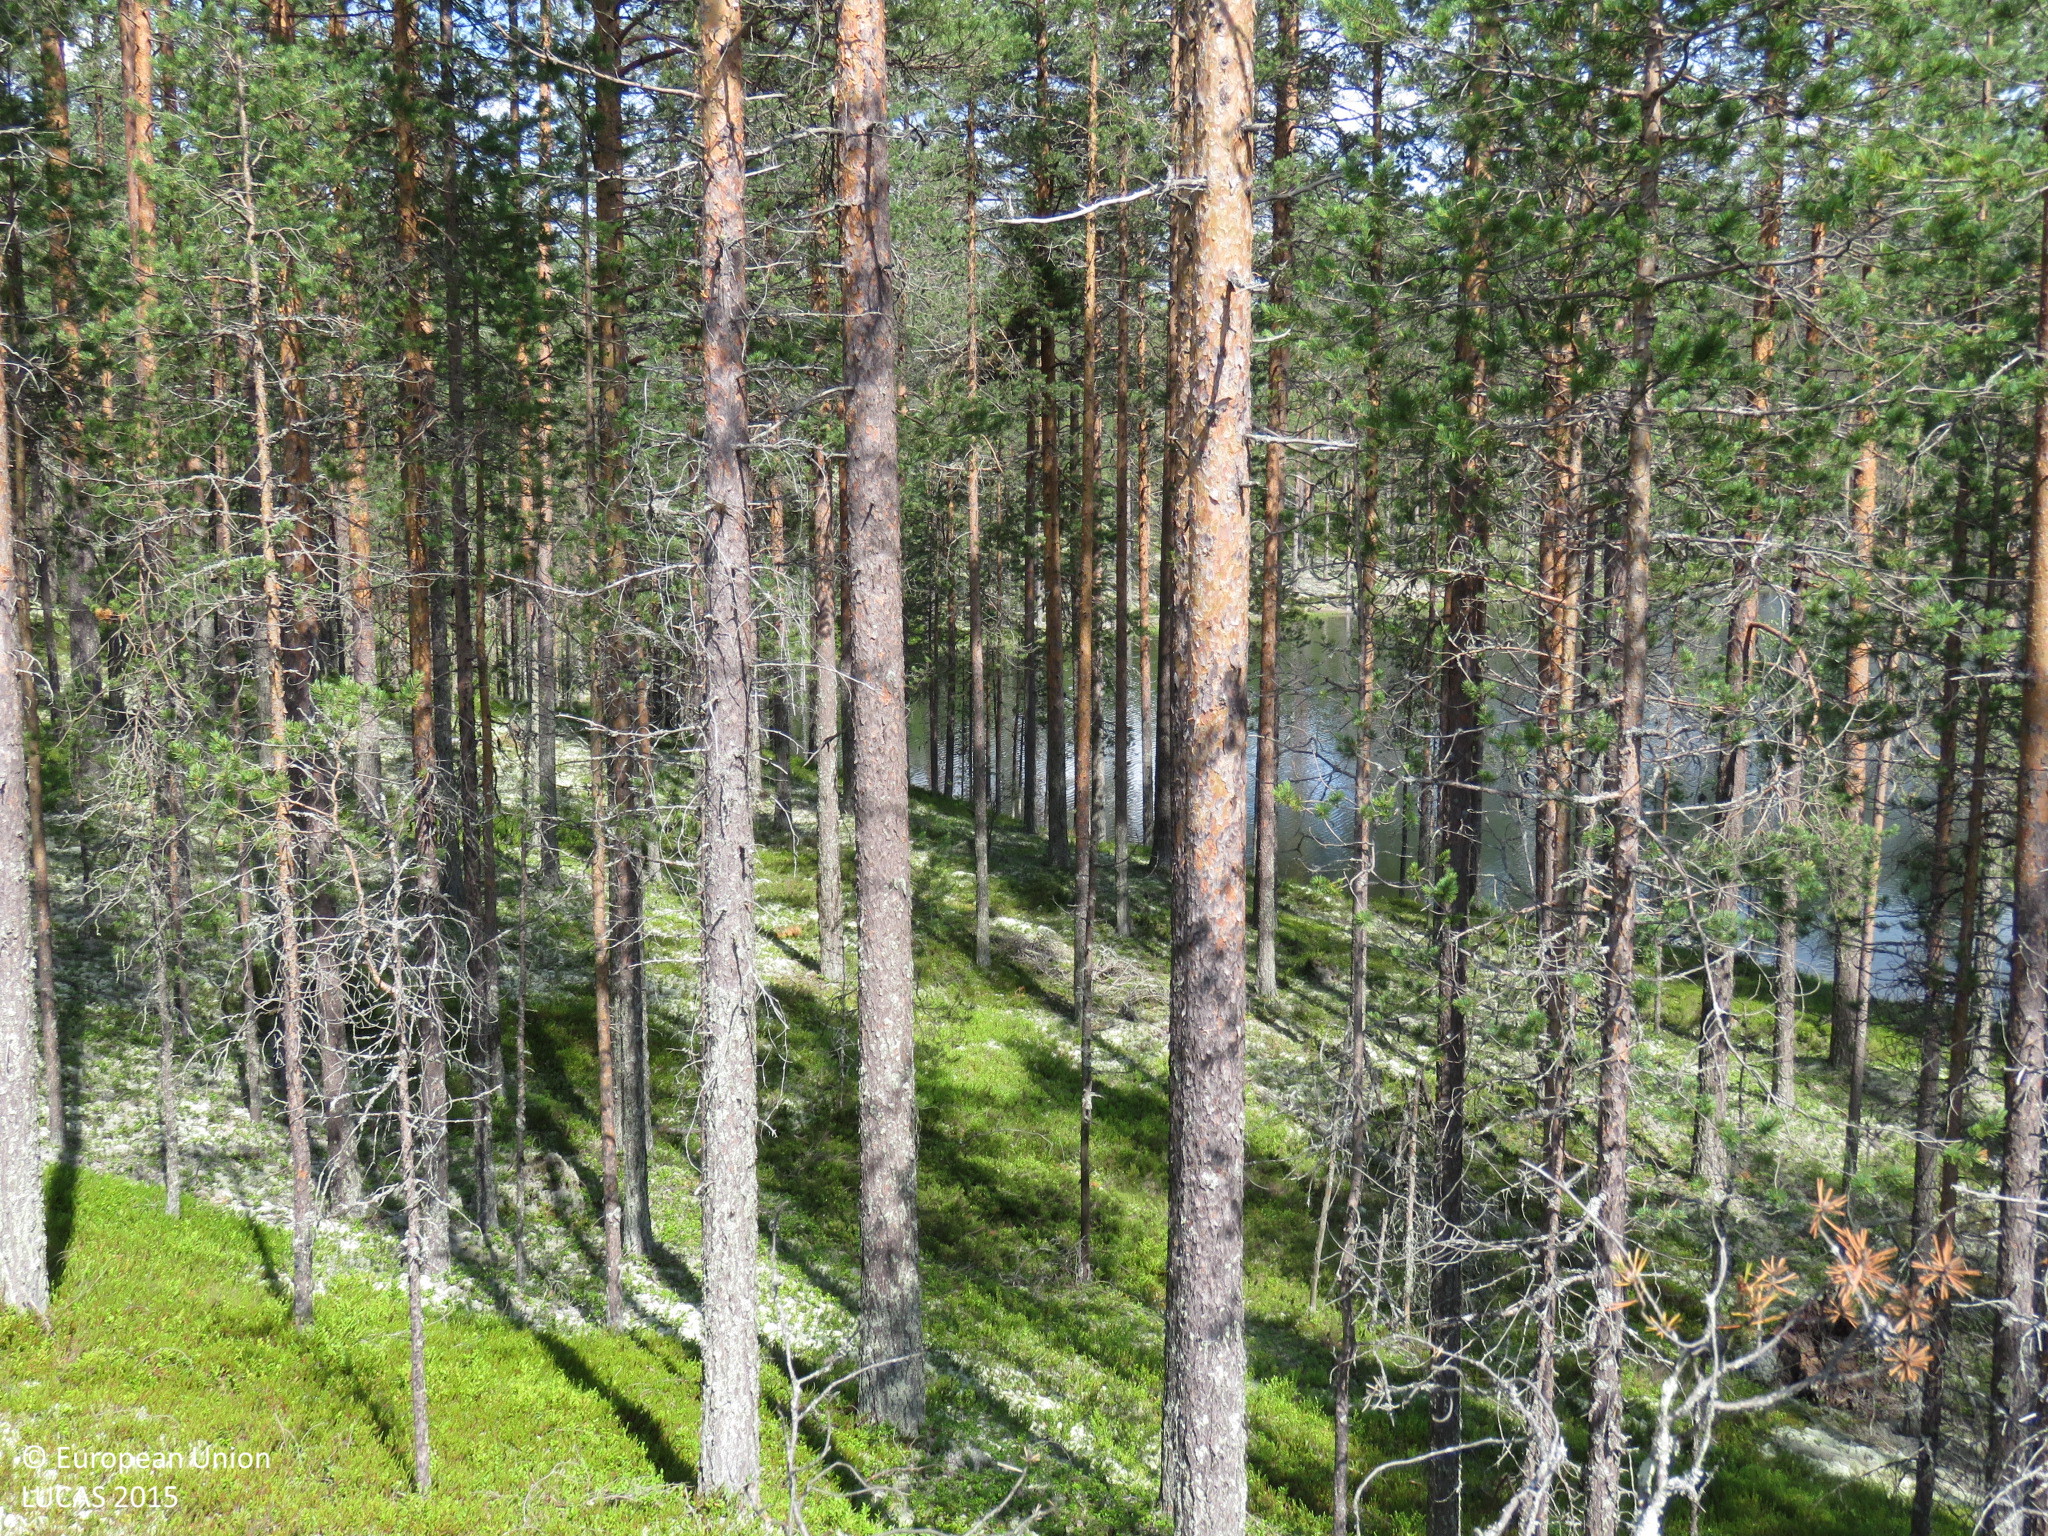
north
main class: Woodland
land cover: Pine dominated coniferous woodland
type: boreal forest
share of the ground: > 75 %
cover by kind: coniferous forest trees 75 %, lichens and mosses 15 %, shrubs 10 %
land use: Forestry
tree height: > 5 m
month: July
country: FI
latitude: 64.5342
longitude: 26.6049
